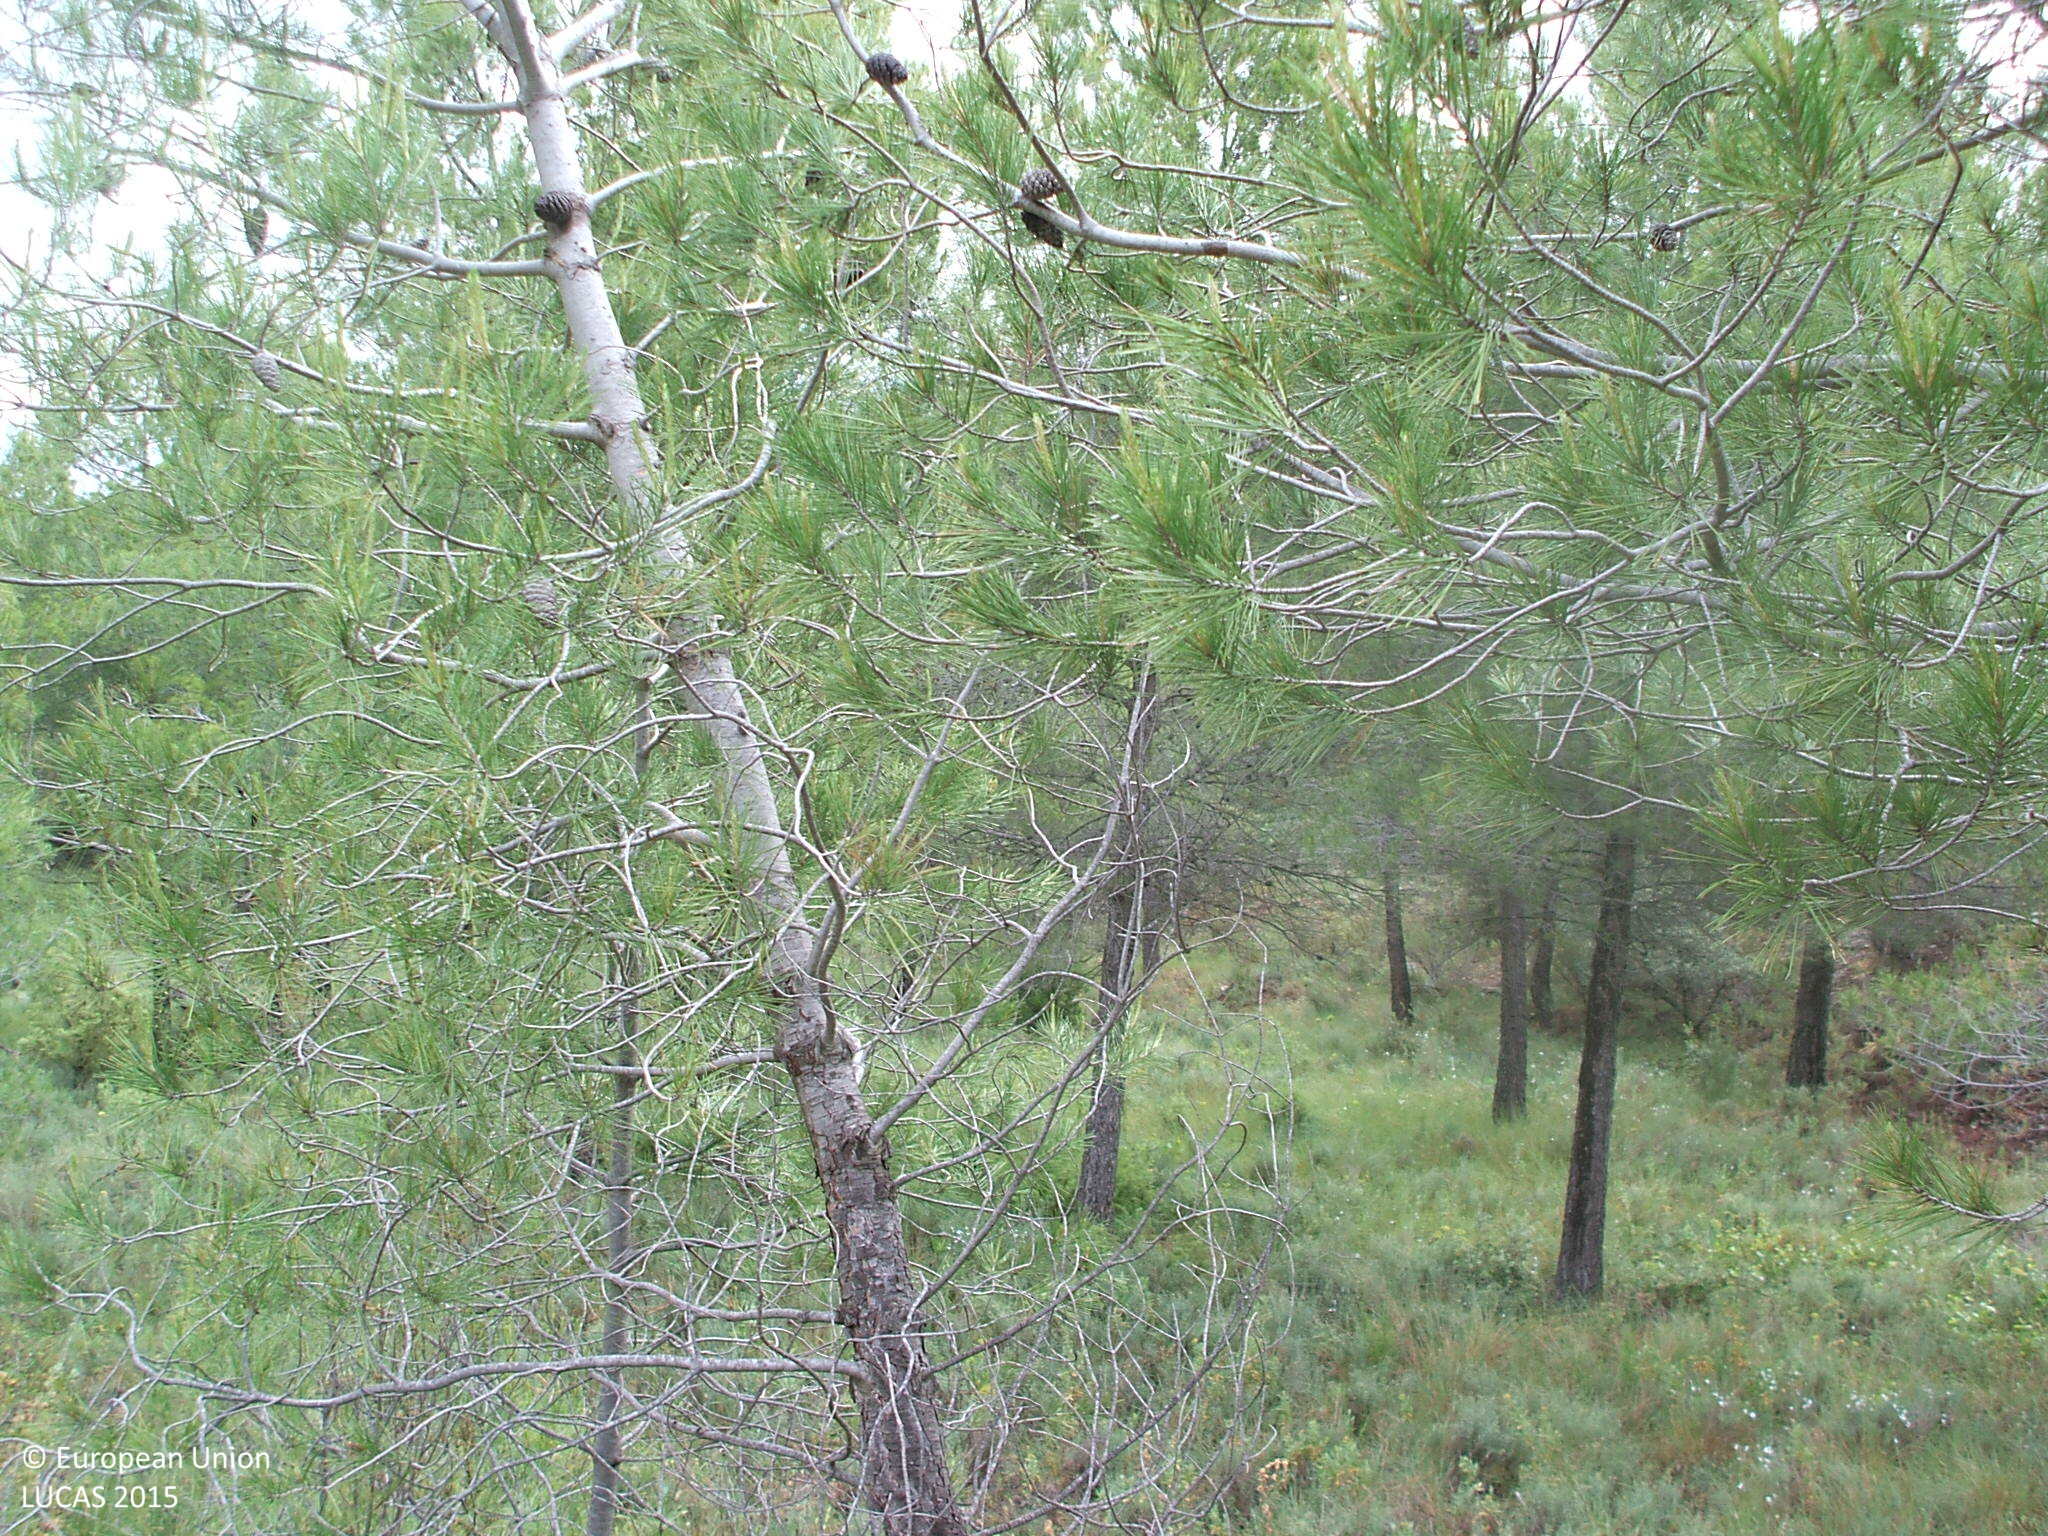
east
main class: Woodland
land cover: Pine dominated coniferous woodland
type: coniferous forest of the mediterranean region
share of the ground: 25 - 50 %
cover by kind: shrubs 70 %, coniferous forest trees 30 %
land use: Semi-natural and natural areas not in use
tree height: > 5 m
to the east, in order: Pine dominated coniferous woodland; Dry stone walls; Pine dominated coniferous woodland; Dry stone walls; Pine dominated coniferous woodland; Dry stone walls; Pine dominated coniferous woodland; Pine dominated mixed woodland; Tracks; Pine dominated mixed woodland
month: June
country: ES
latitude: 40.8674
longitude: 0.0128
